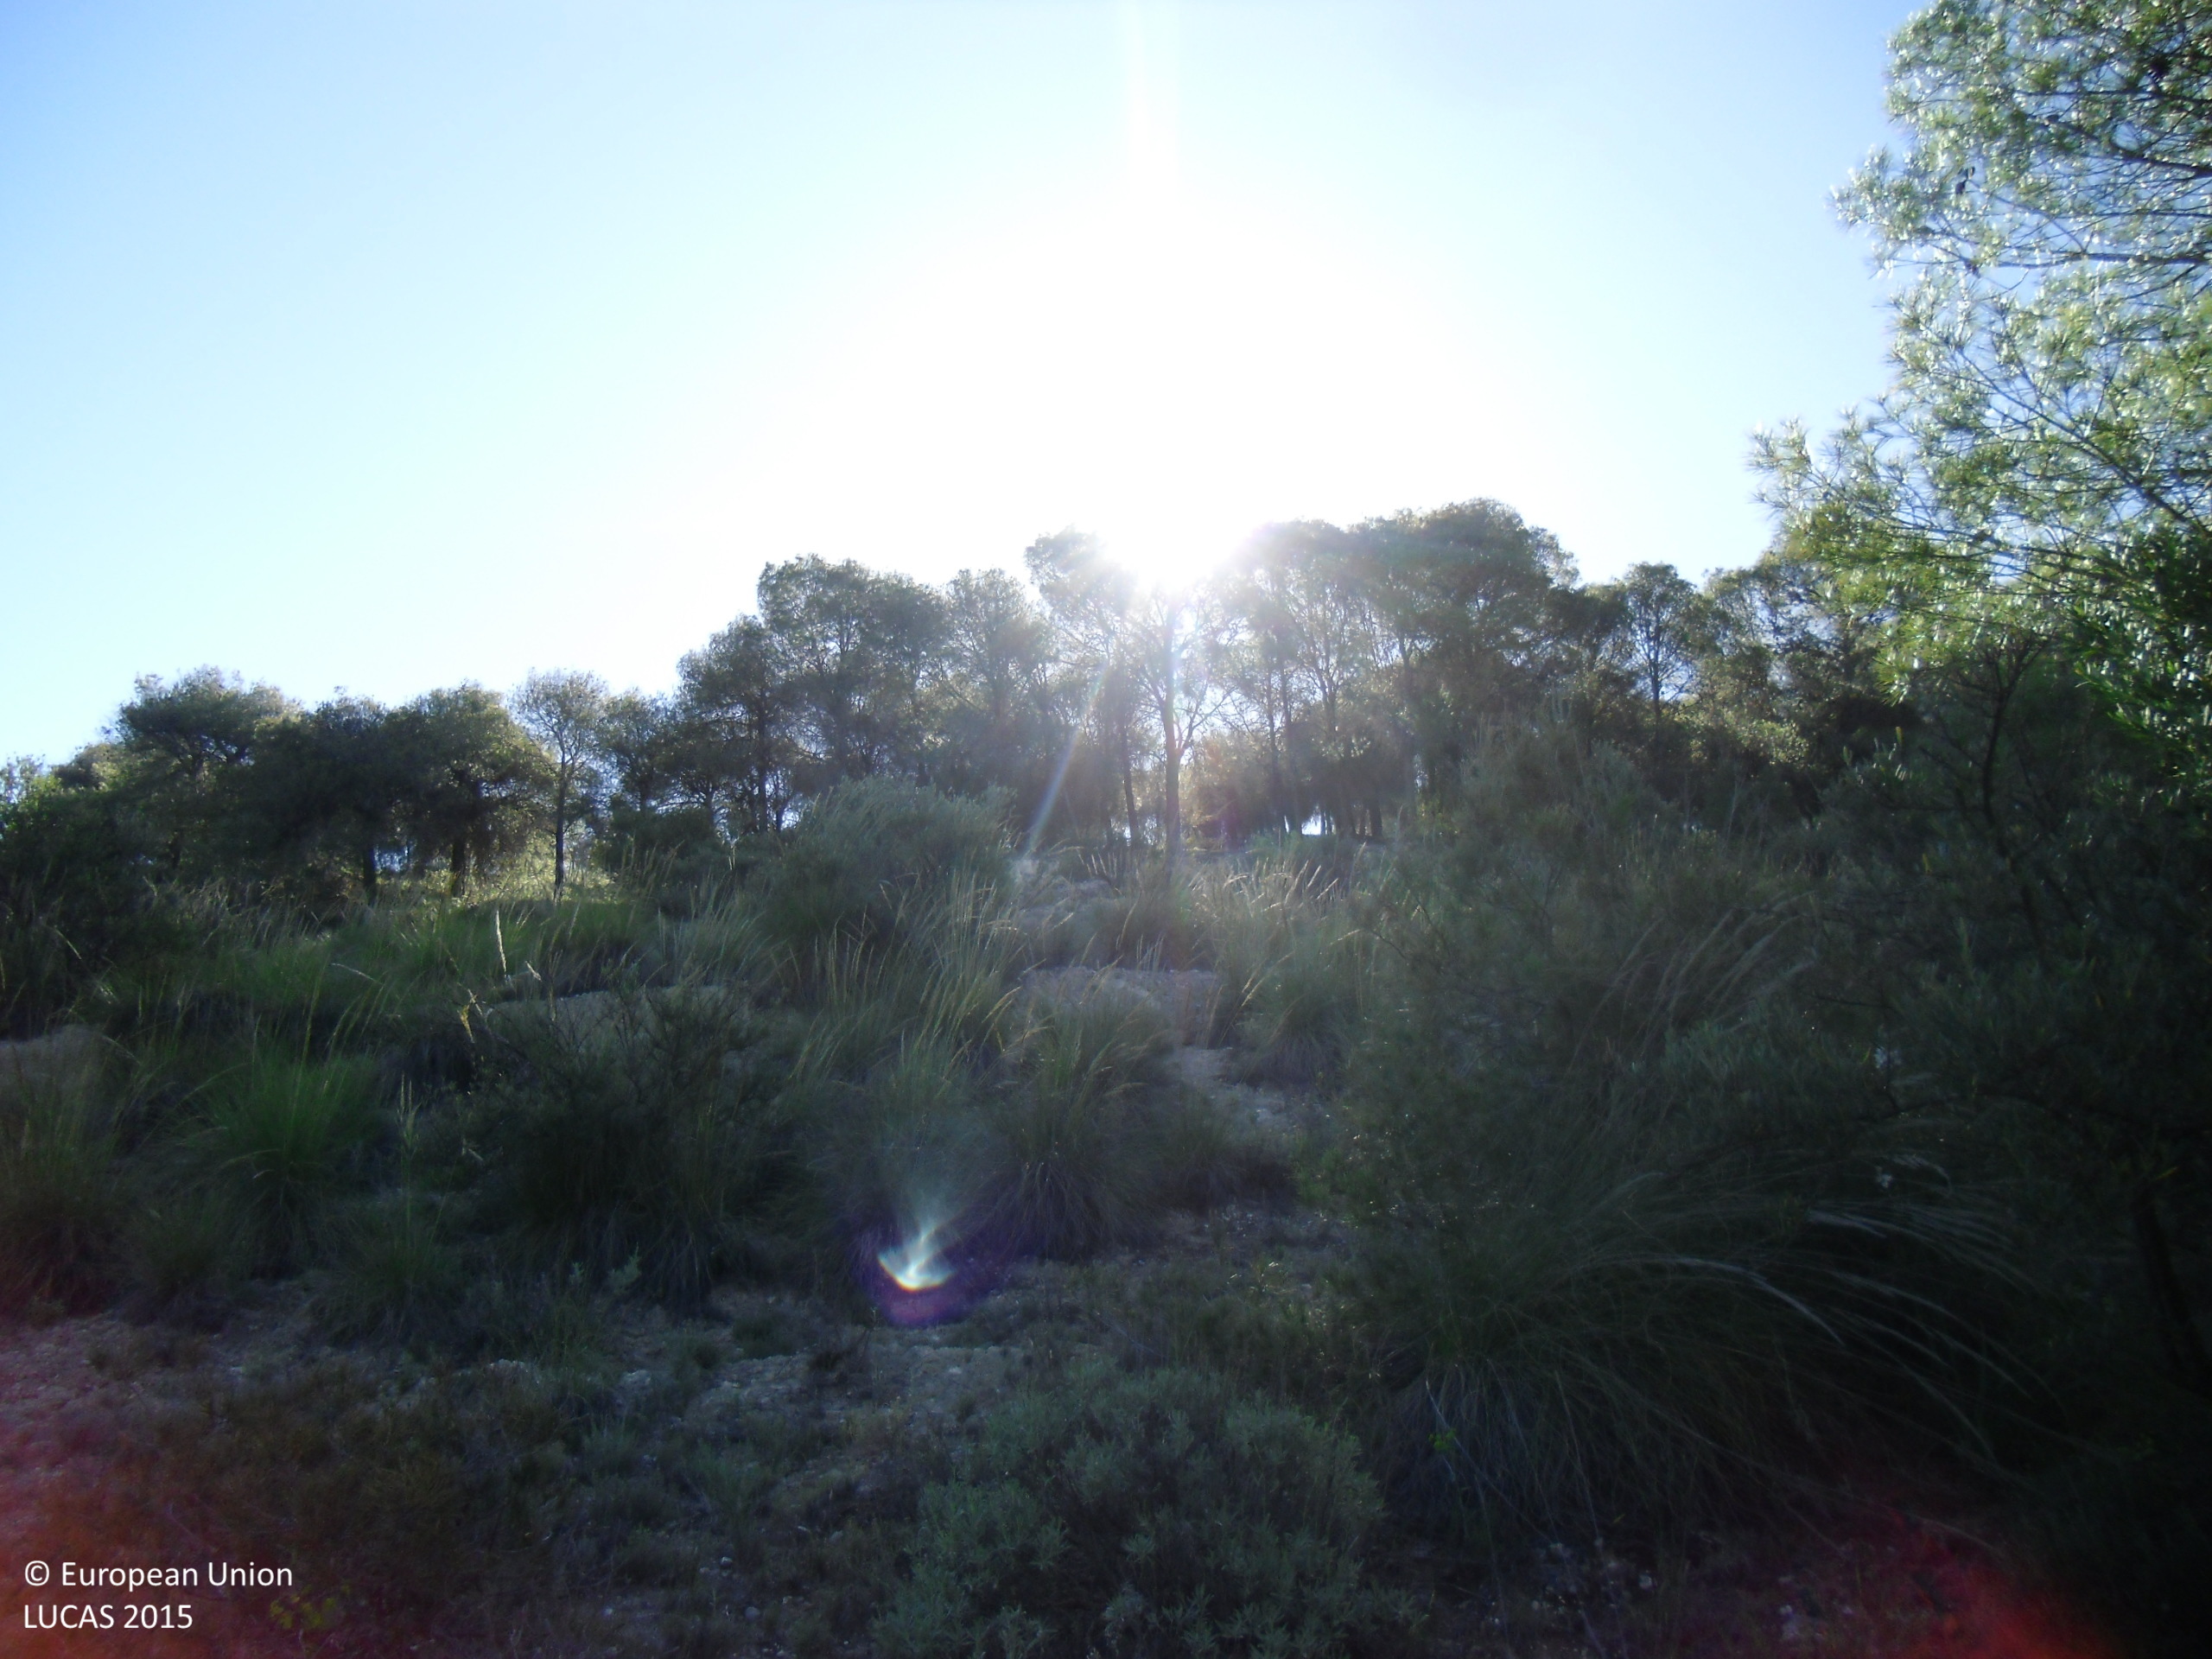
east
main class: Woodland
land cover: Pine dominated coniferous woodland
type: coniferous forest of the mediterranean region
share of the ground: 25 - 50 %
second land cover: Olive groves
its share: 50 - 75 %
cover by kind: coniferous forest trees 50 %, herbaceous plants 30 %, shrubs 20 %
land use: Forestry
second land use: Agriculture (excluding fallow land and kitchen gardens)
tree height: > 5 m
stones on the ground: 10 - 25 %
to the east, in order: Pine dominated coniferous woodland; Olive groves; Pine dominated coniferous woodland; Olive groves; Rivers and streams; Olive groves; Tracks; Pine dominated coniferous woodland; Olive groves
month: May
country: ES
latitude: 40.2743
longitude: -2.8799
